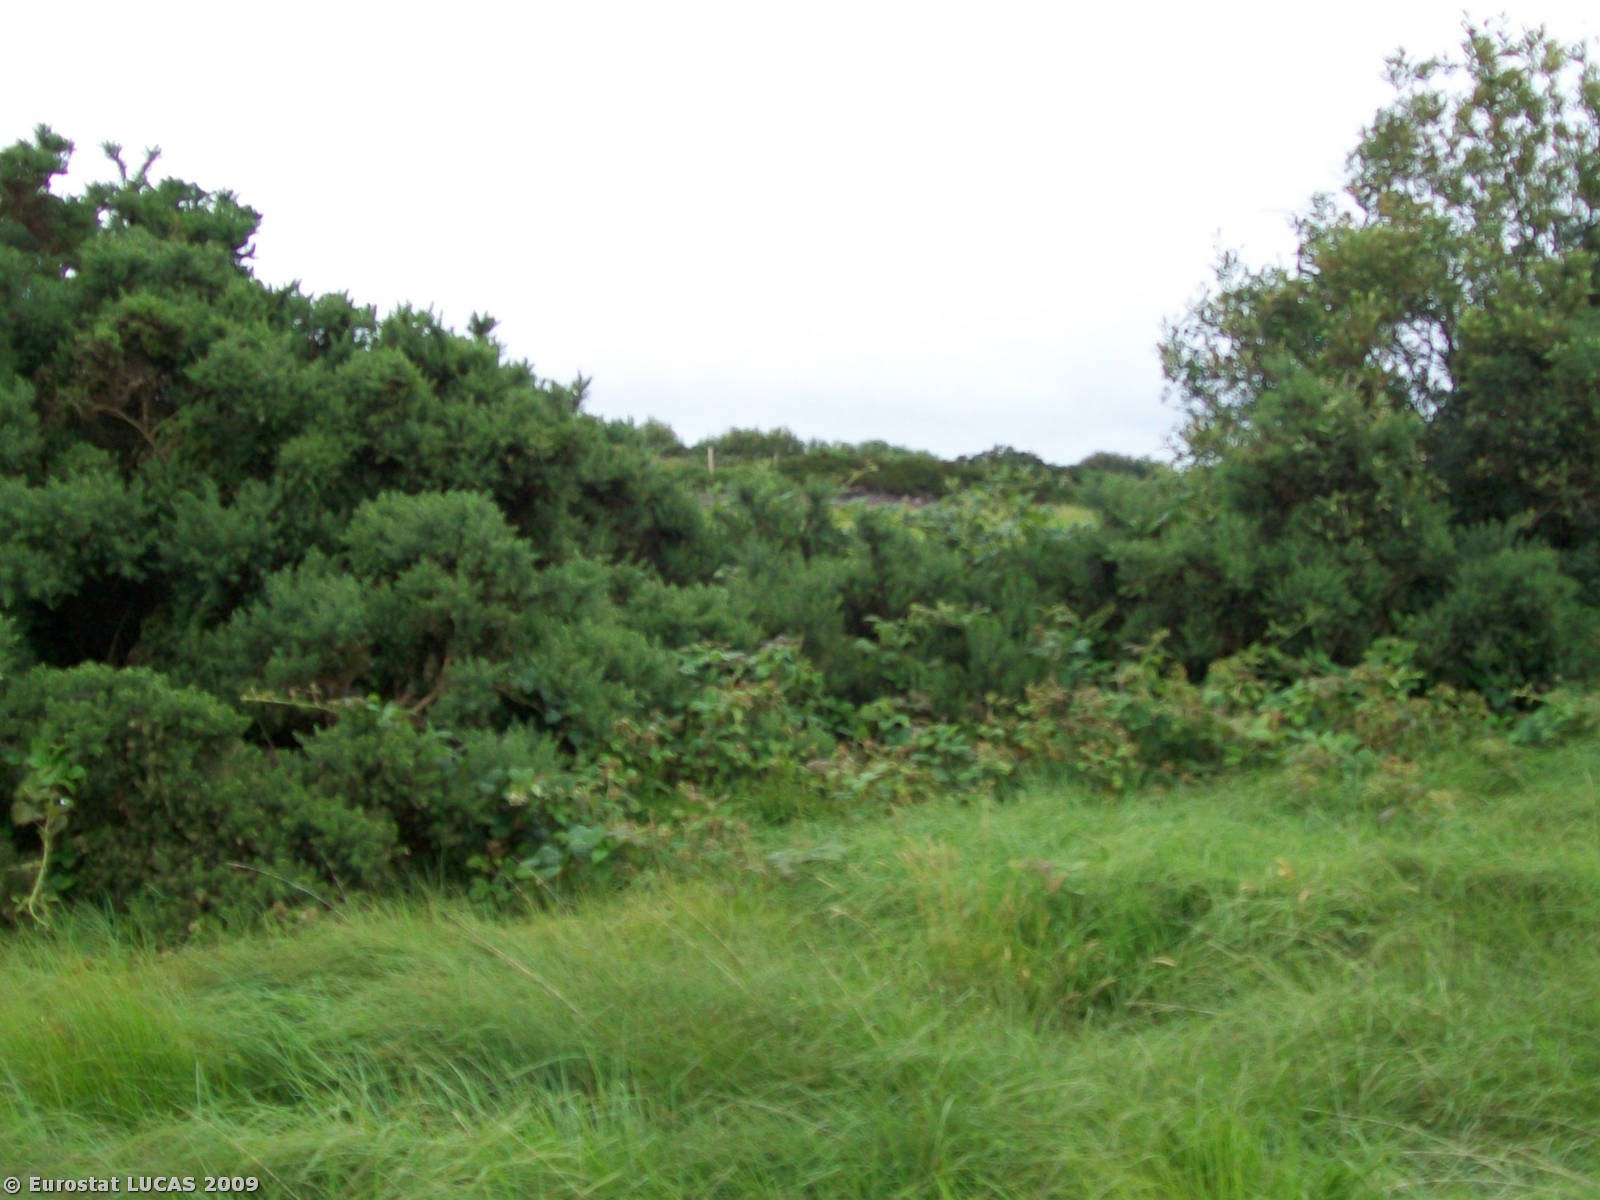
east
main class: Grassland
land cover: Grassland without tree/shrub cover
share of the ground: > 75 %
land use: Agriculture (excluding fallow land and kitchen gardens)
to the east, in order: Grassland without tree/shrub cover; Abandoned hedges; Grassland without tree/shrub cover; Bare land; Fences; Spontaneously vegetated surfaces; Peatbogs
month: July
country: IE
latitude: 53.6474
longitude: -8.9225
